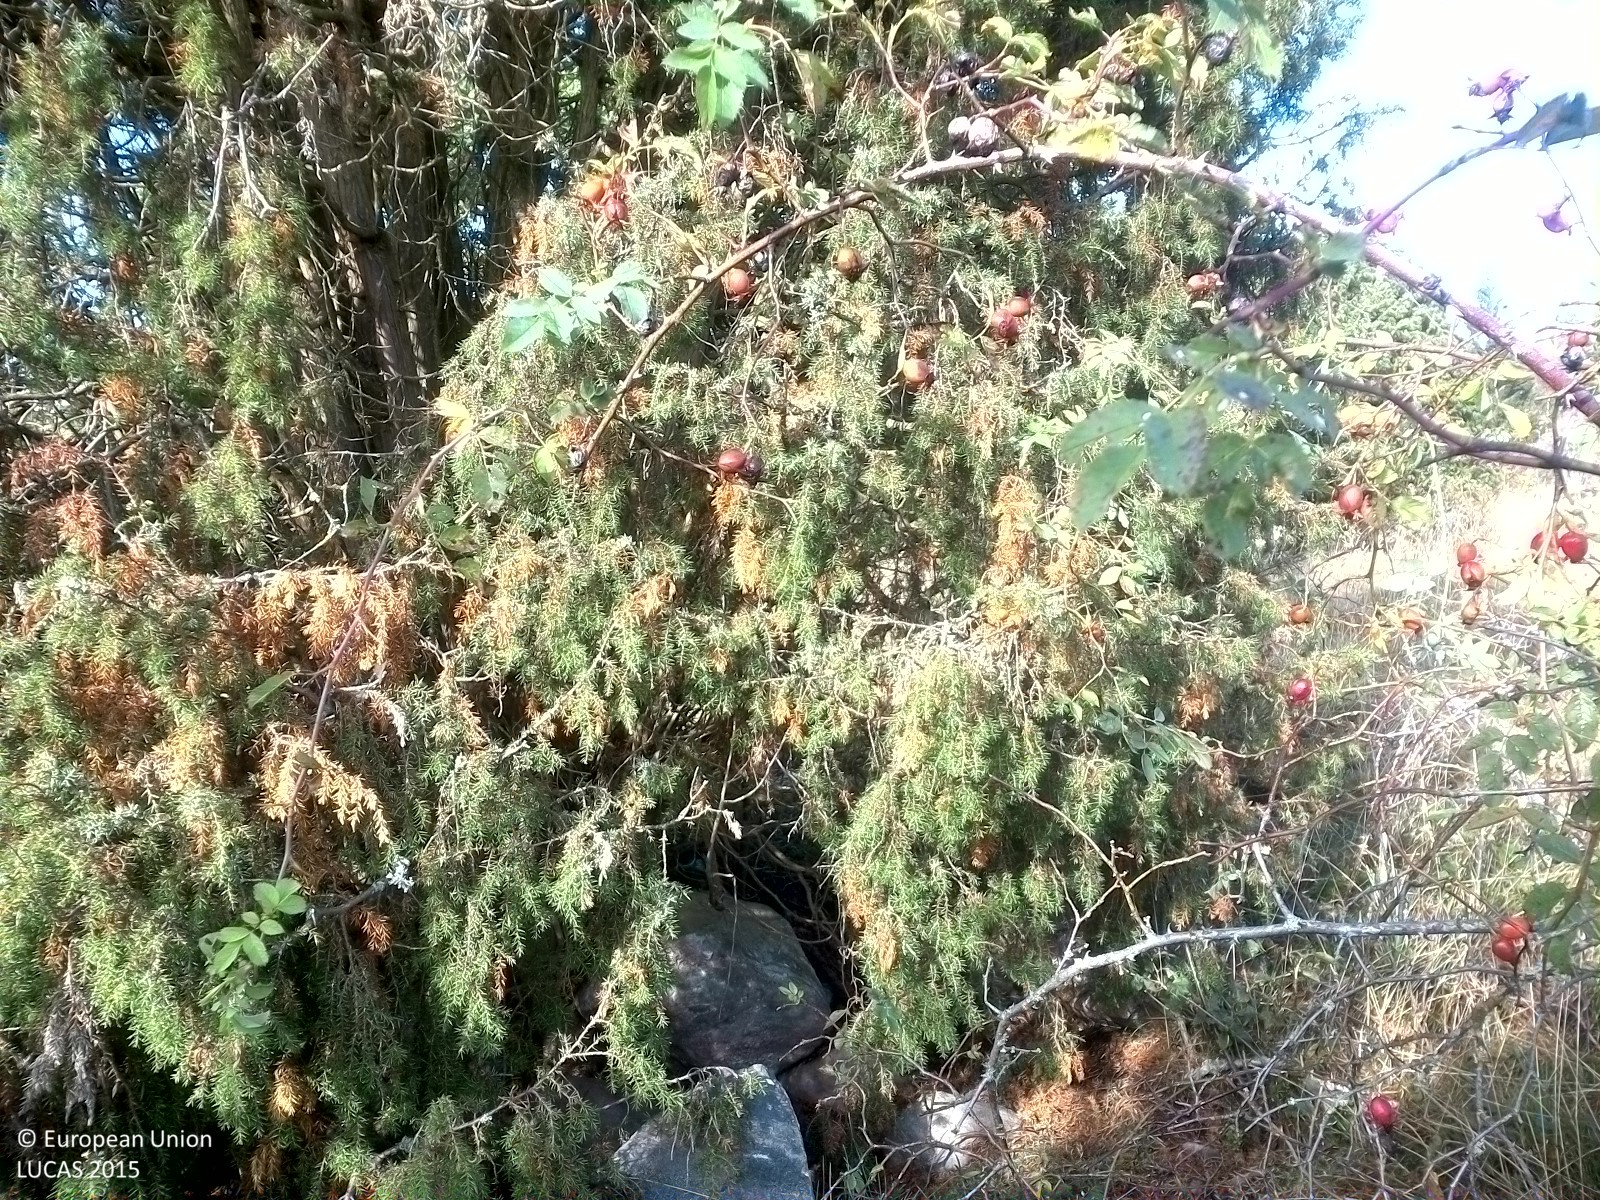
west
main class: Grassland
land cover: Grassland with sparse tree/shrub cover
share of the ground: > 75 %
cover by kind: herbaceous plants 90 %, broadleaved forest trees 5 %, shrubs 5 %
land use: Agriculture (excluding fallow land and kitchen gardens)
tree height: > 5 m
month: September
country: SE
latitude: 58.5477
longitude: 16.5426
